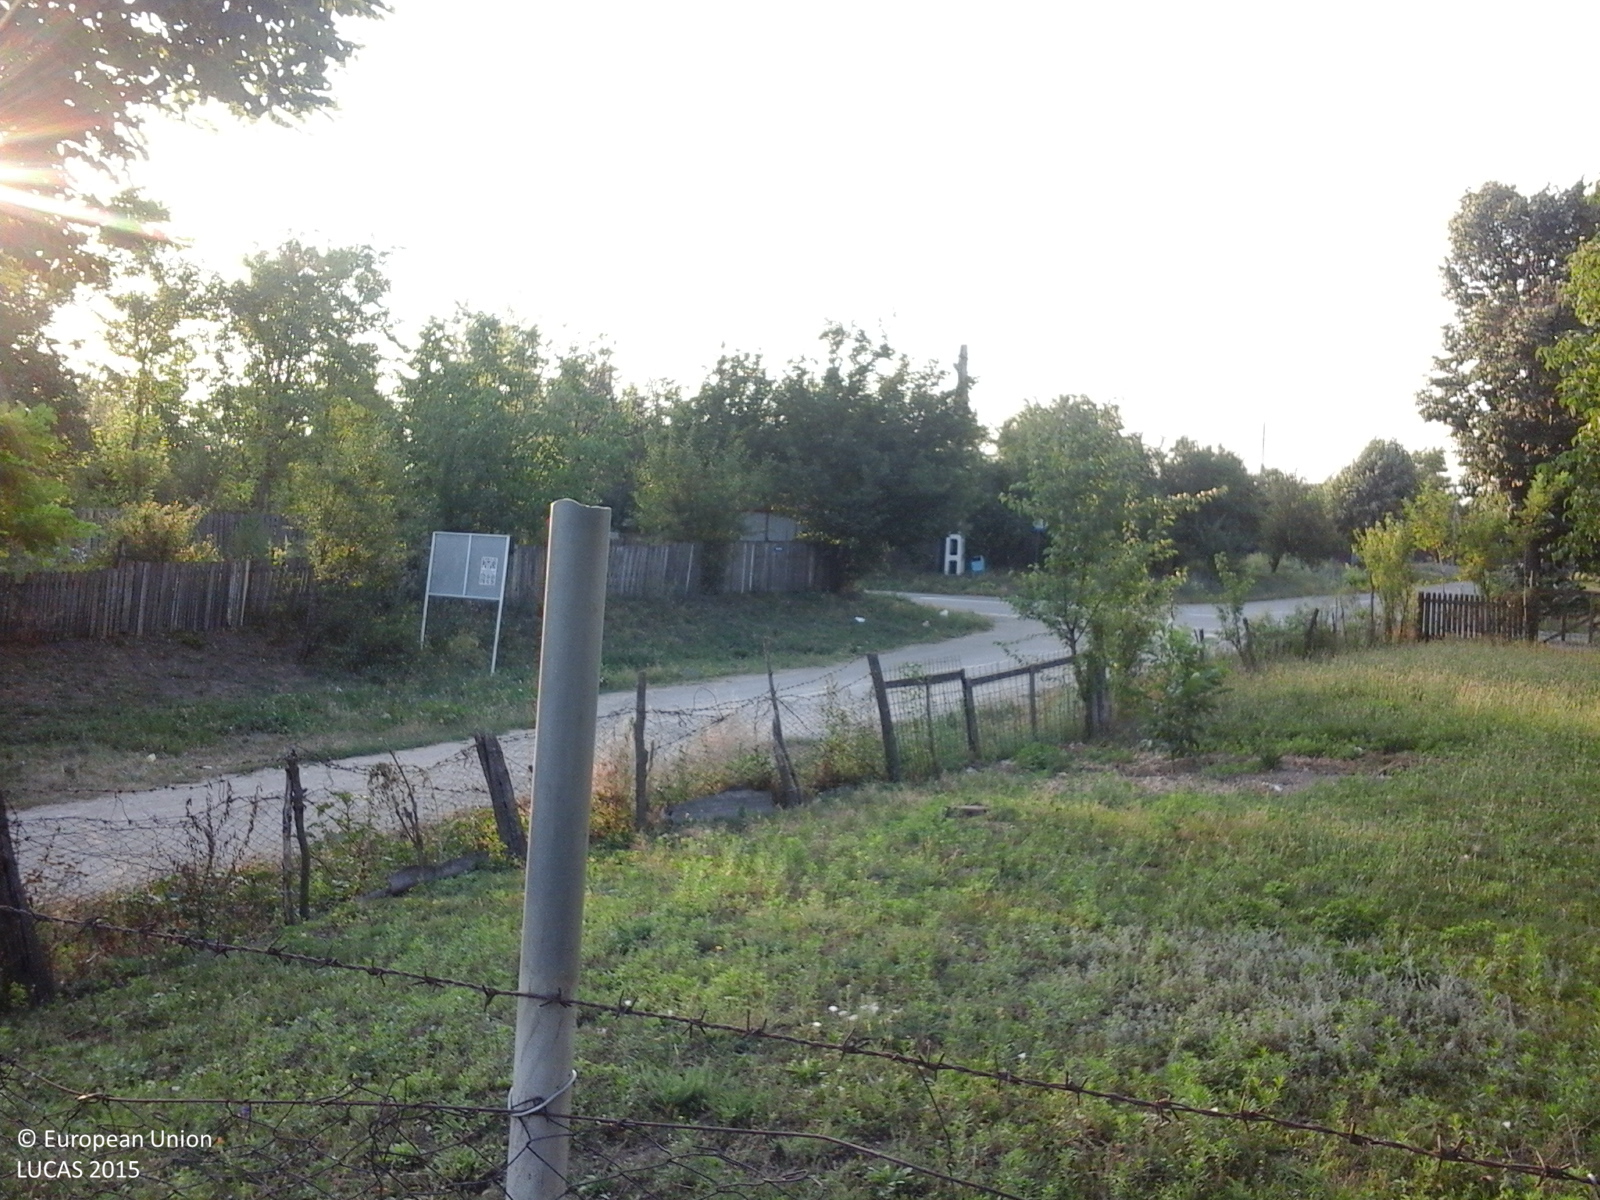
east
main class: Grassland
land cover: Grassland without tree/shrub cover
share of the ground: > 75 %
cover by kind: herbaceous plants 100 %
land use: Agriculture (excluding fallow land and kitchen gardens)
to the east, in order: Grassland without tree/shrub cover; Artificial constructions in urban areas; Vineyards; Abandoned hedges; Arable land (only in case pi); Abandoned hedges; Spontaneously vegetated surfaces; Artificial constructions in urban areas
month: July
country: RO
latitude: 44.6011
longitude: 27.0515
